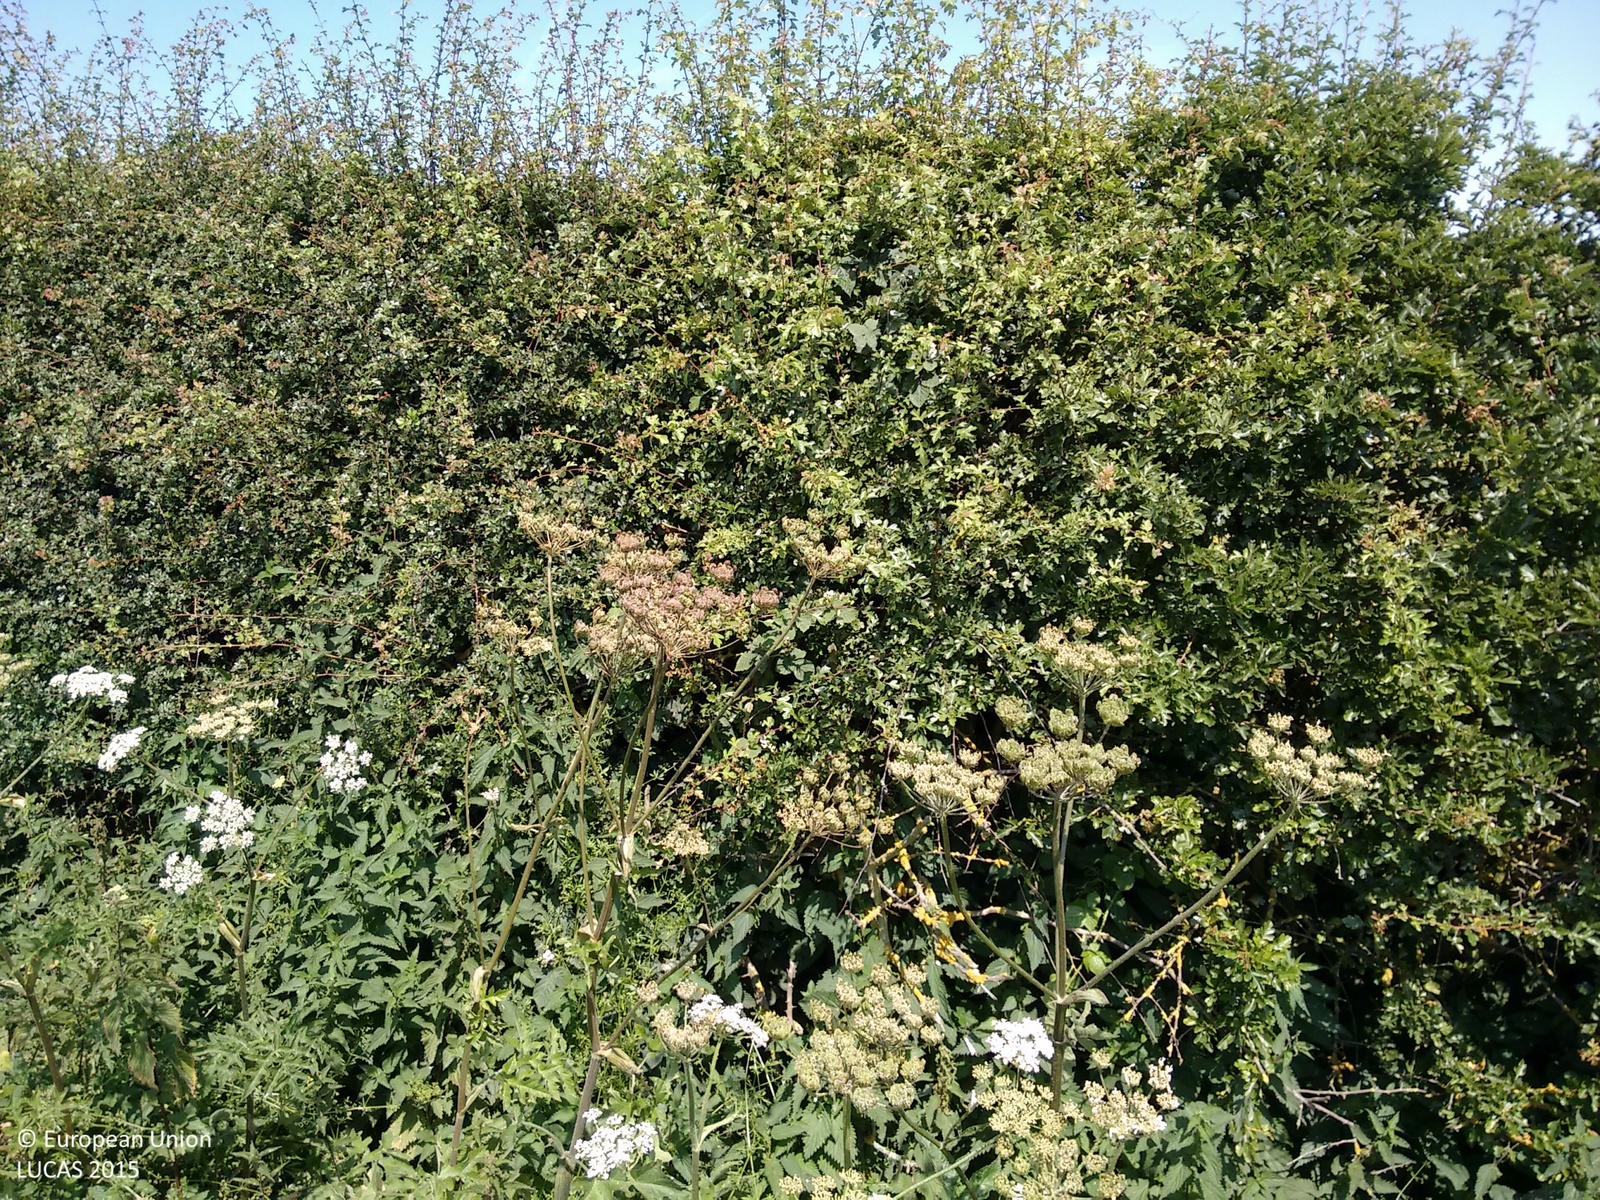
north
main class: Cropland
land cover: Rape and turnip rape
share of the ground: > 75 %
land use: Agriculture (excluding fallow land and kitchen gardens)
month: July
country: GB
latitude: 53.2319
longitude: -0.9340
